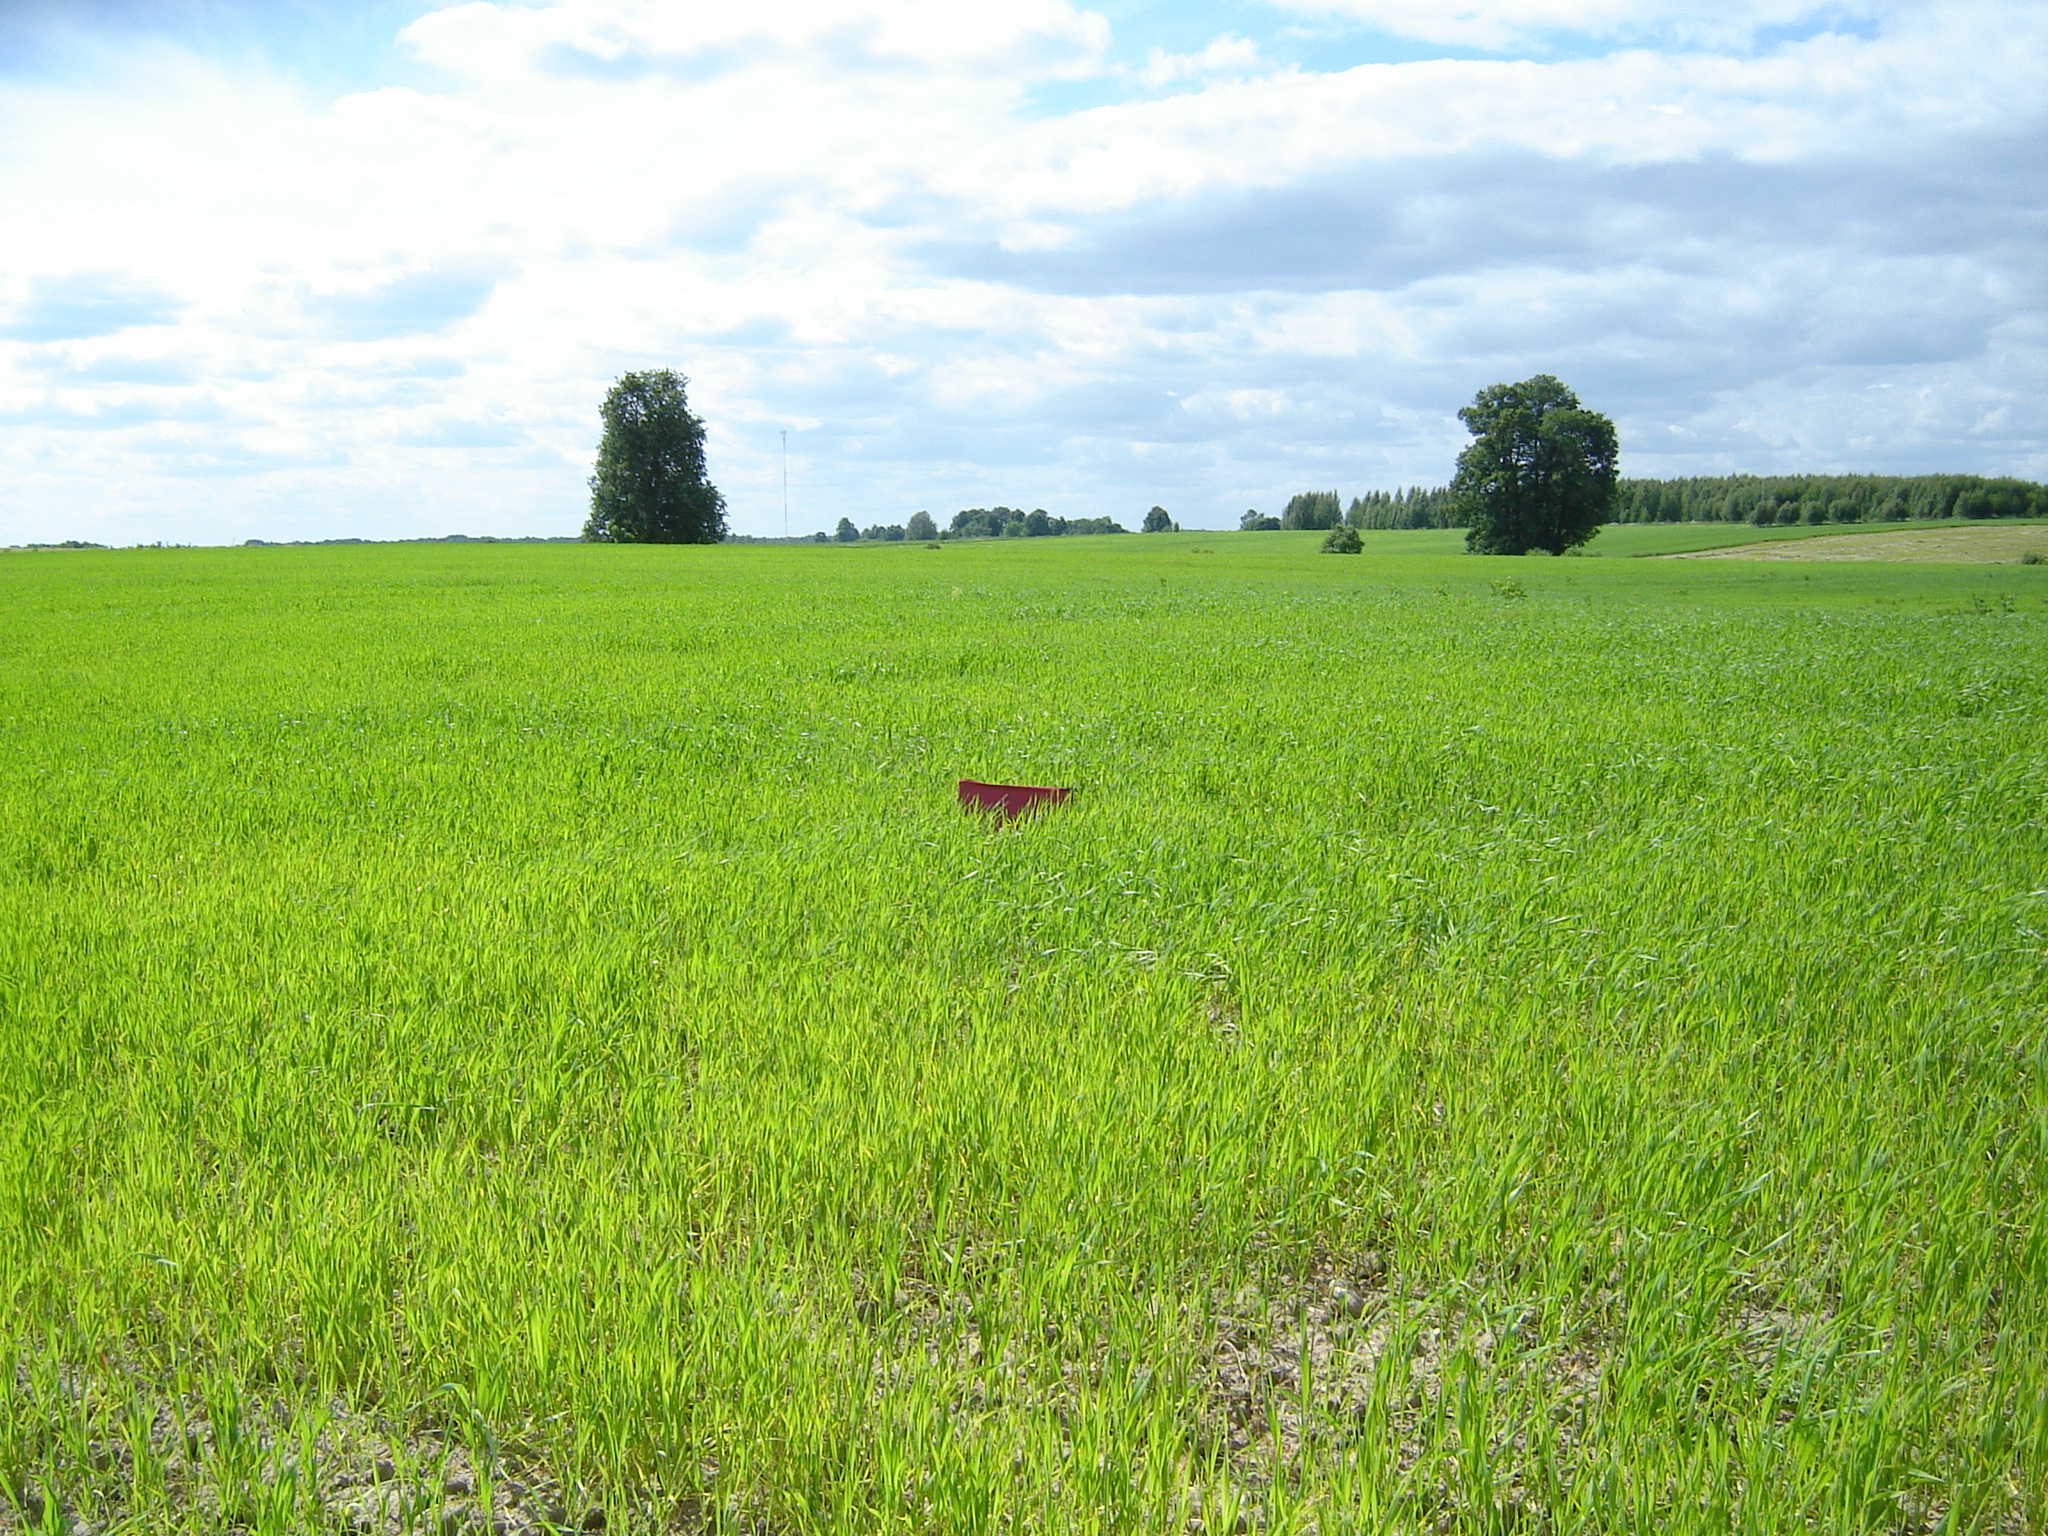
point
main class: Cropland
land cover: Common wheat
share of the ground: > 75 %
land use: Agriculture (excluding fallow land and kitchen gardens)
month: June
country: LT
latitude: 55.3849
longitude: 24.7383
